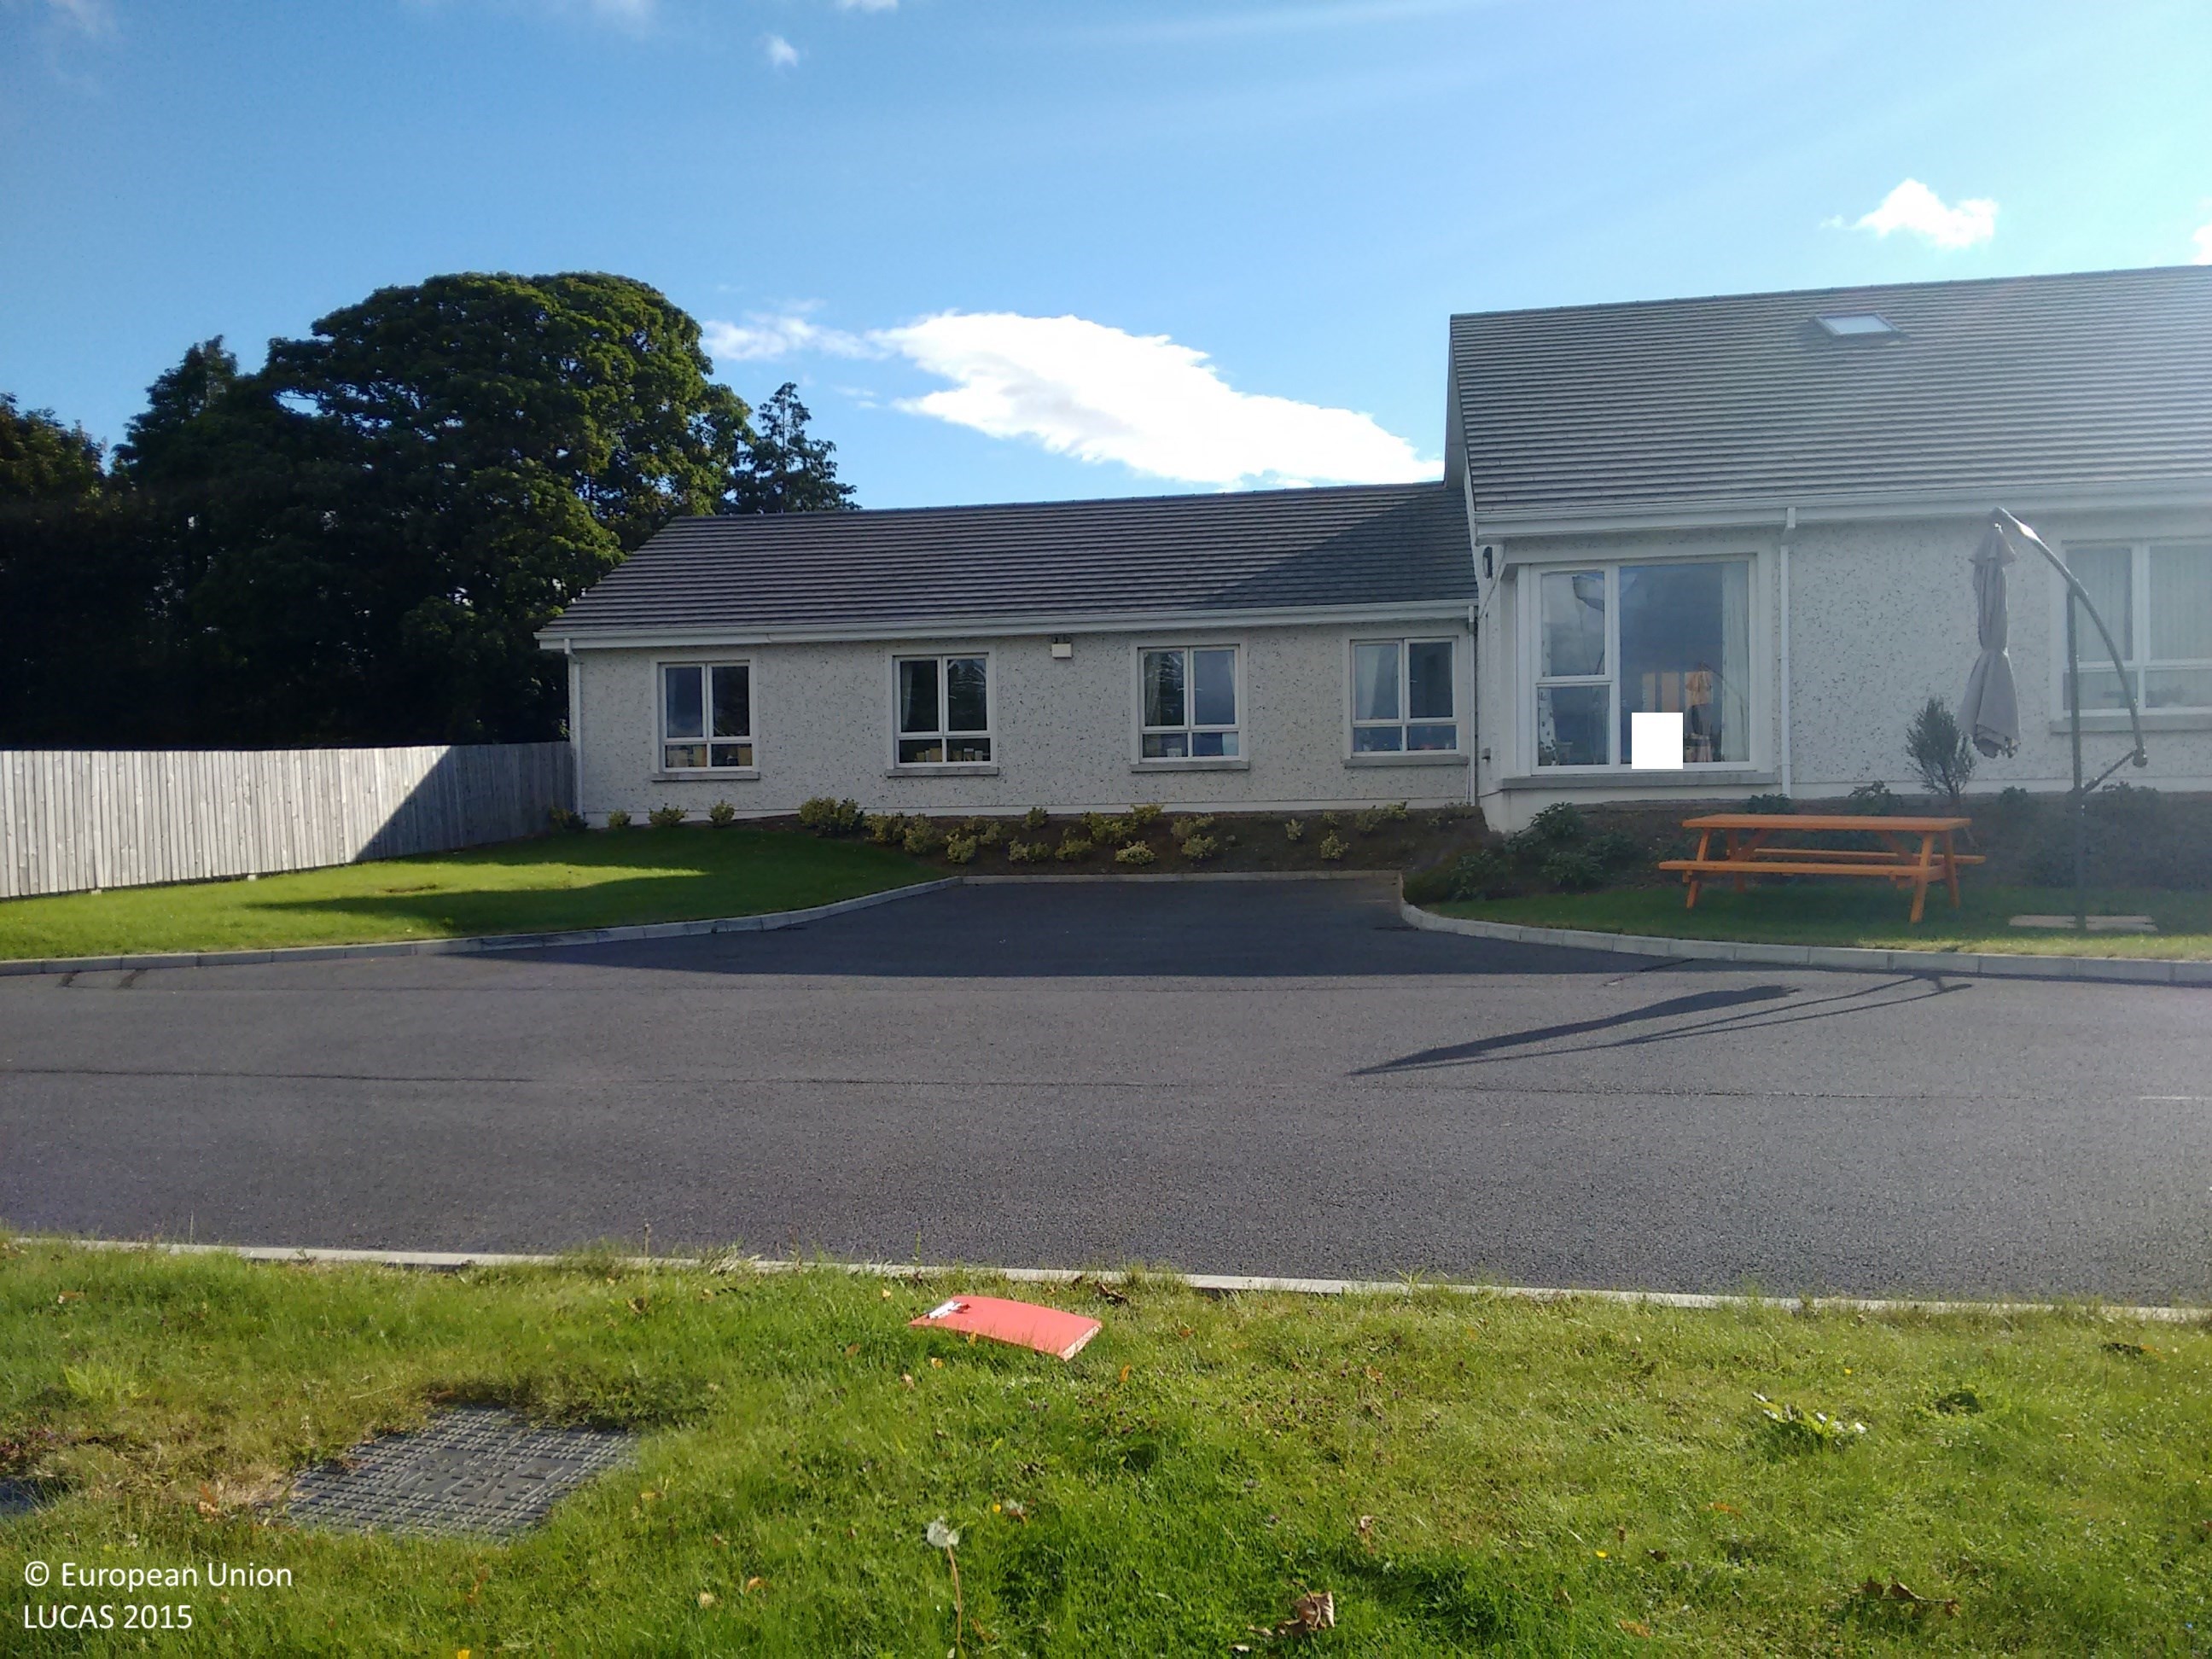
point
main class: Grassland
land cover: Grassland without tree/shrub cover
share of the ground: > 75 %
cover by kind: herbaceous plants 100 %
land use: Residential
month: August
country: IE
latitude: 52.2953
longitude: -7.2627
